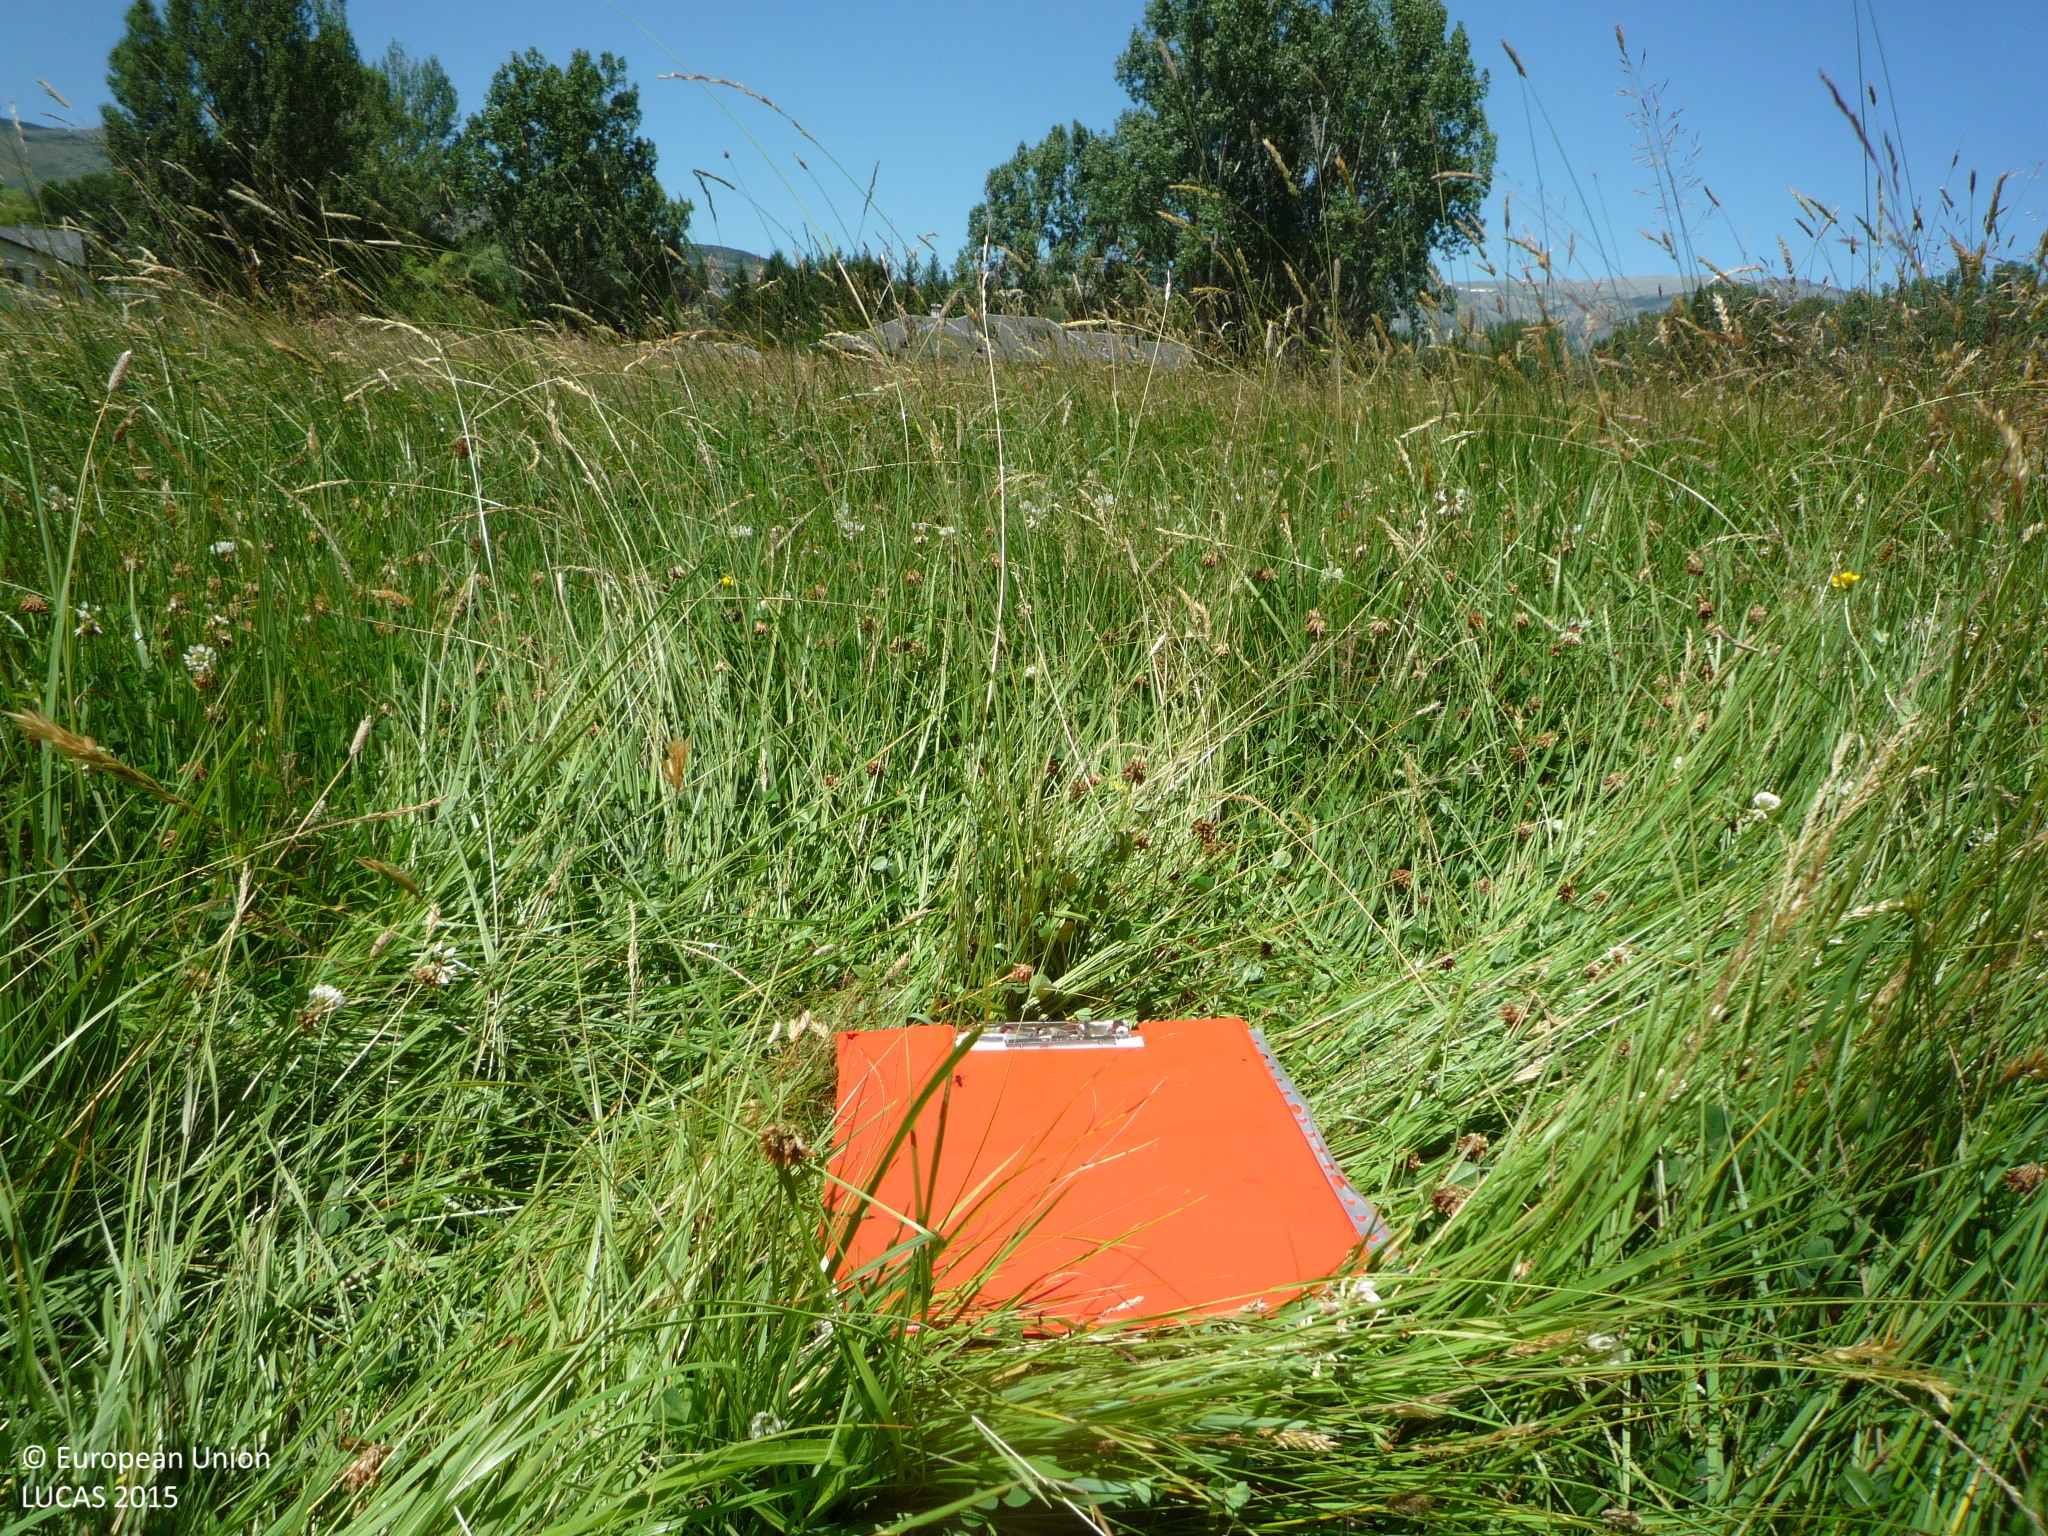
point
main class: Grassland
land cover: Grassland without tree/shrub cover
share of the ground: > 75 %
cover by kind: herbaceous plants 100 %
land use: Semi-natural and natural areas not in use
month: July
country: ES
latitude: 42.4203
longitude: 1.9050
